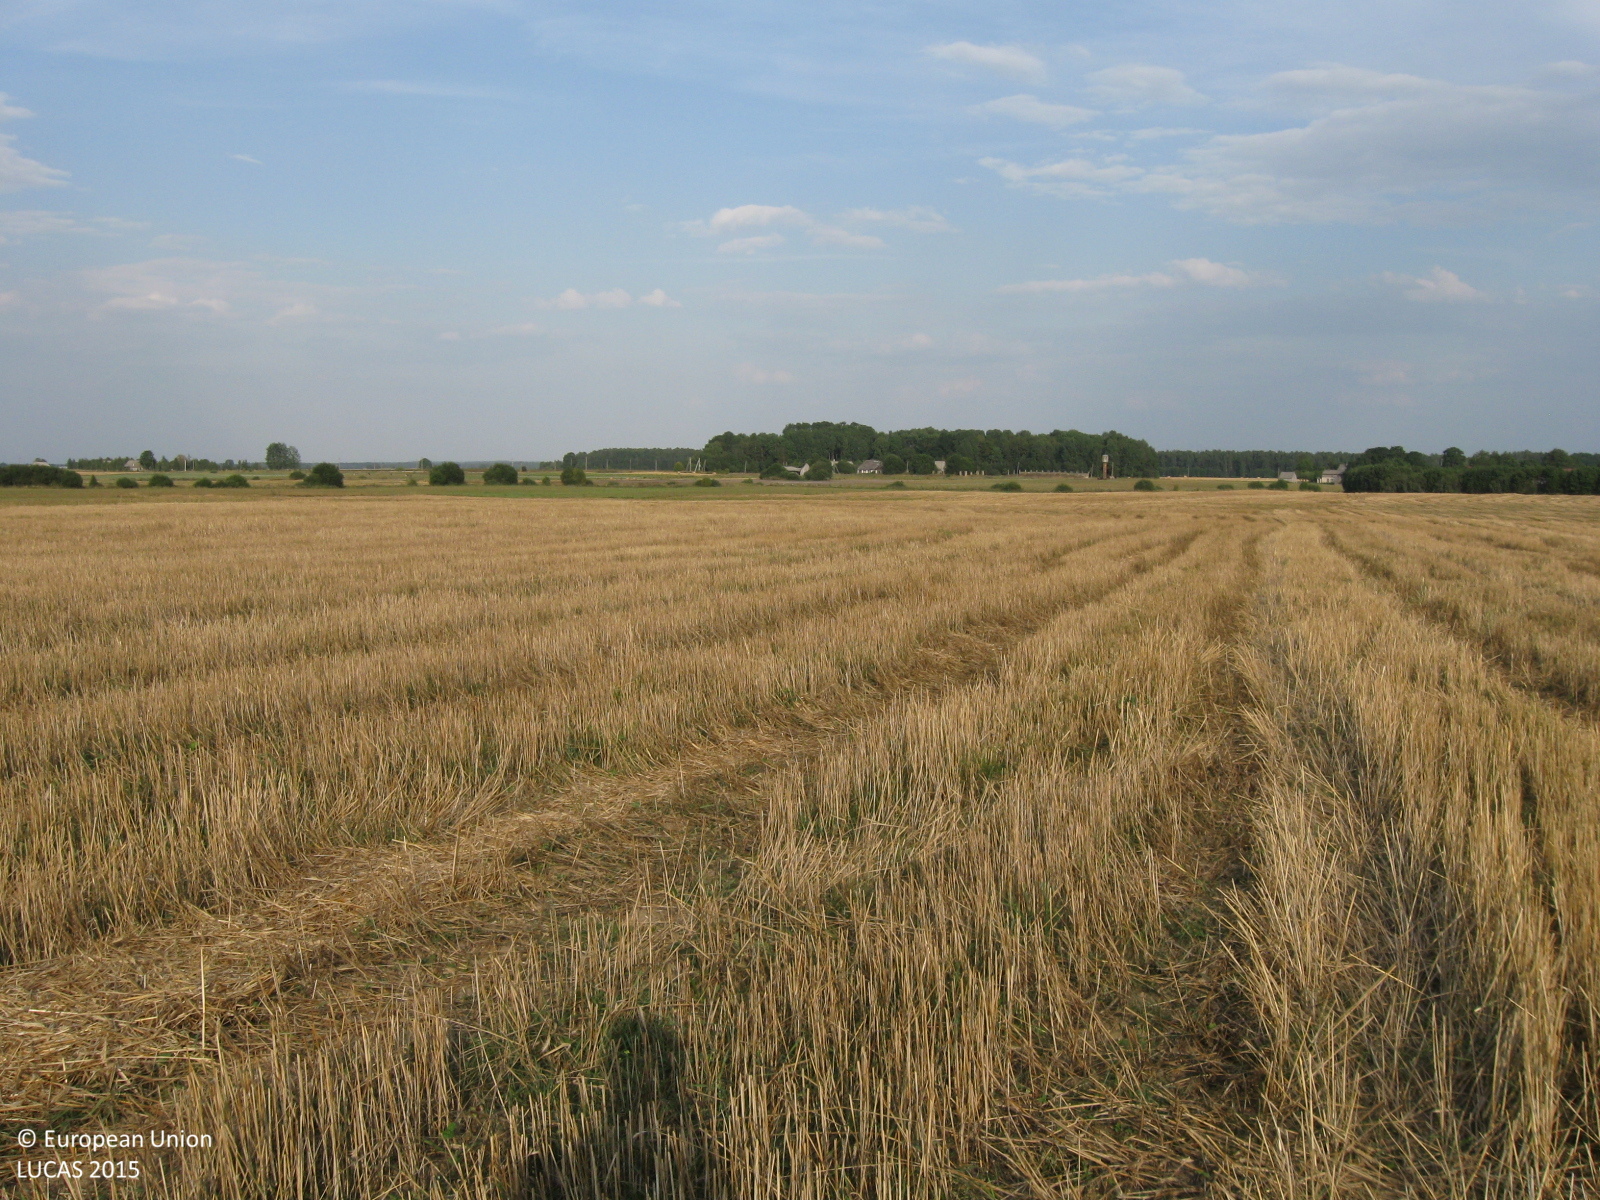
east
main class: Cropland
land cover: Durum wheat
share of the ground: > 75 %
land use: Agriculture (excluding fallow land and kitchen gardens)
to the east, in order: Durum wheat
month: August
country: LT
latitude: 55.5778
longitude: 22.9969
